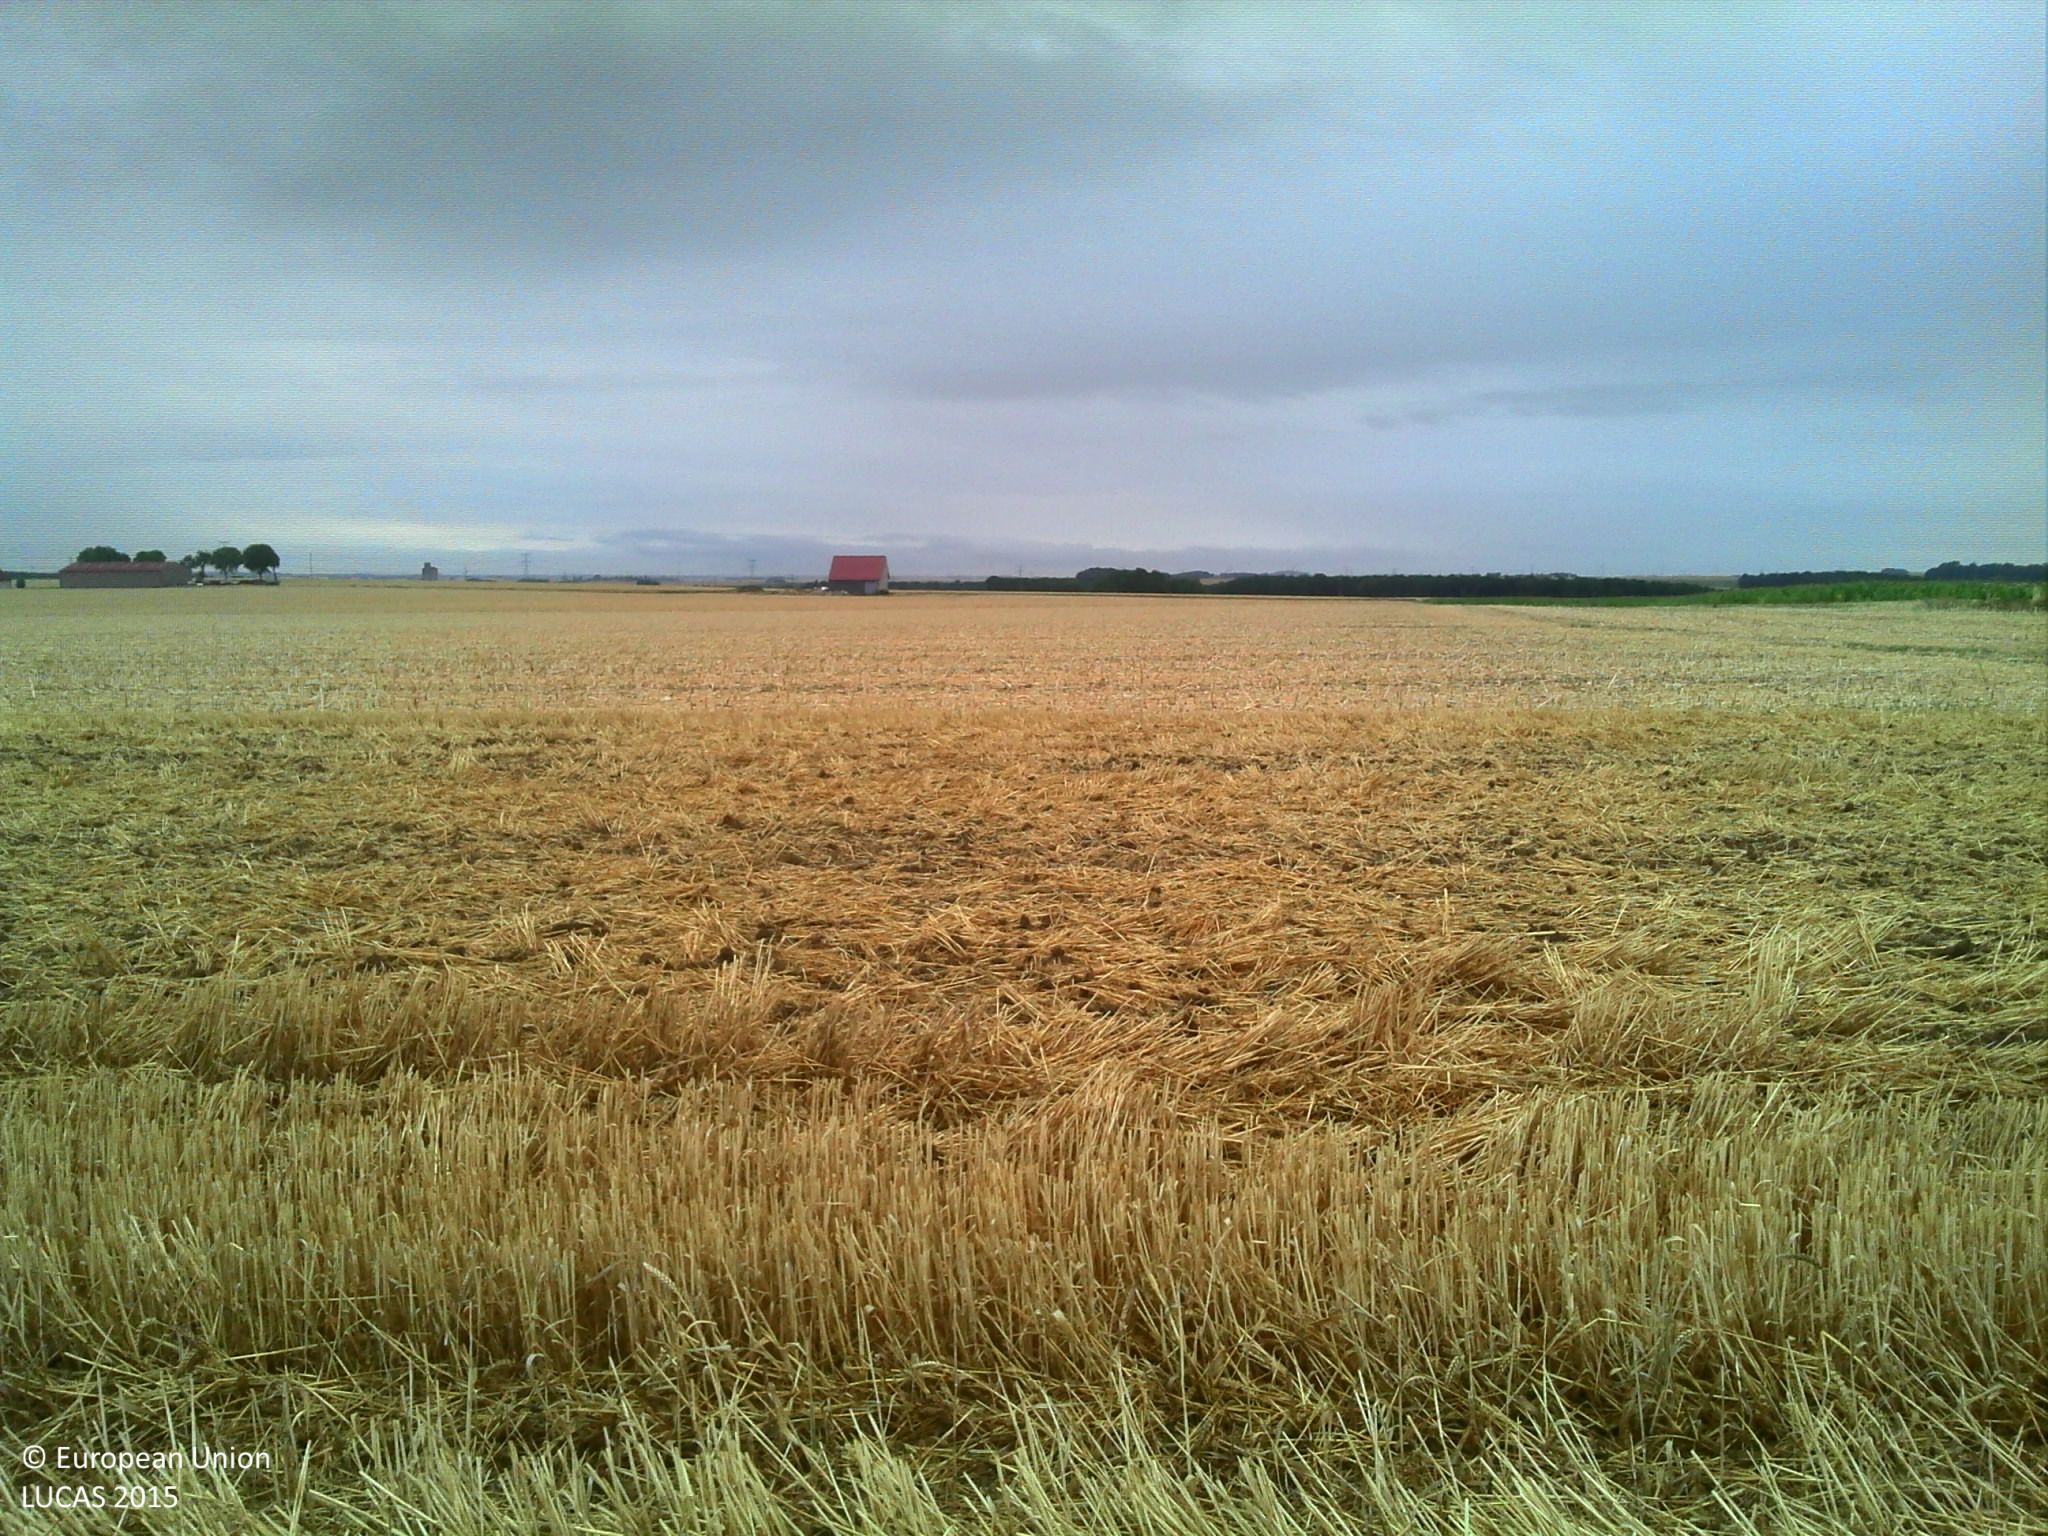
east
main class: Cropland
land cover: Common wheat
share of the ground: > 75 %
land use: Agriculture (excluding fallow land and kitchen gardens)
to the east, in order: Common wheat; Rape and turnip rape
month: August
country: FR
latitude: 48.5637
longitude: 3.3398
